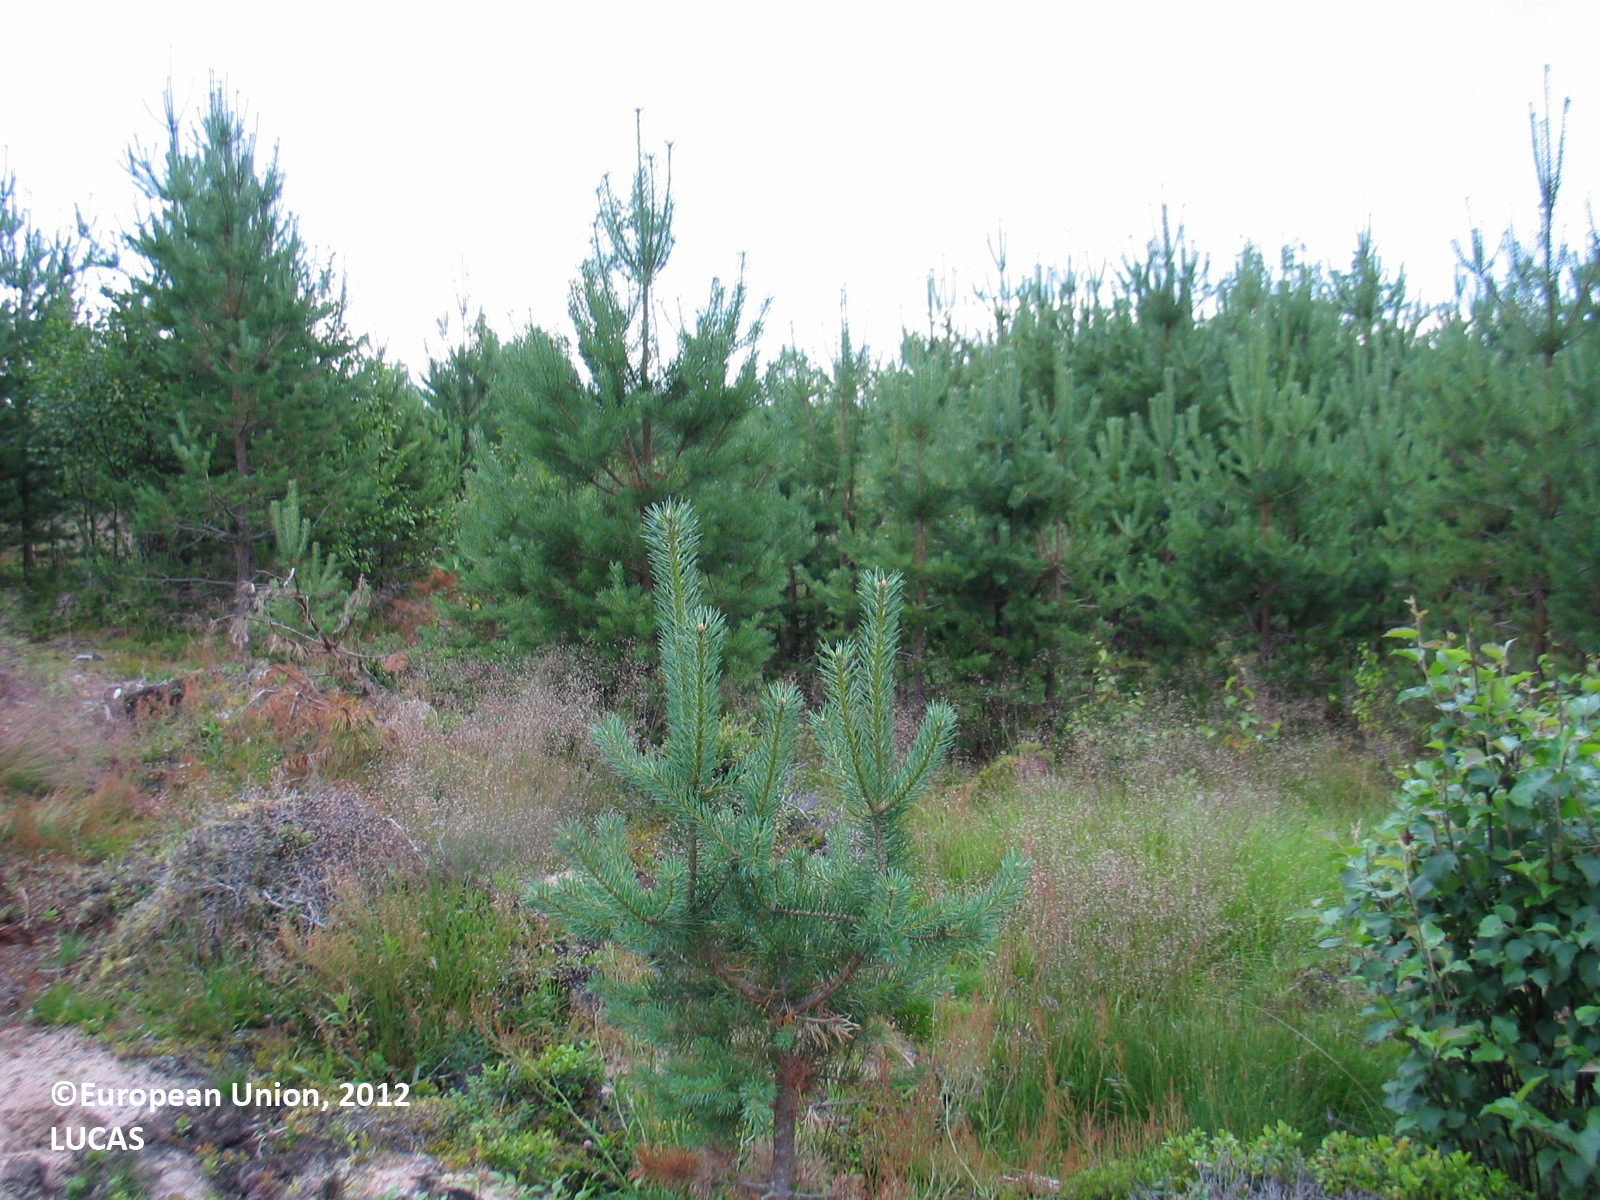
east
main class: Grassland
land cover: Grassland with sparse tree/shrub cover
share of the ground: > 75 %
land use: Forestry
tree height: < 5 m
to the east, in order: Grassland with sparse tree/shrub cover; Pine dominated coniferous woodland; Grassland with sparse tree/shrub cover; Ditches and canals; Grassland with sparse tree/shrub cover; Broadleaved woodland; Ditches and canals; Other mixed woodland; Ditches and canals; Broadleaved woodland; Ditches and canals; Broadleaved woodland; Ditches and canals; Other mixed woodland; Ditches and canals; Shrubland with sparse tree cover; Ditches and canals; Grass margins; Temporary grasslands; Grass margins; Ditches and canals; Grass margins; Temporary grasslands; Grass margins; Ditches and canals; Grass margins; Temporary grasslands; Grass margins; Ditches and canals; Grass margins; Temporary grasslands
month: July
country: FI
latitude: 64.5595
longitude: 26.3631
